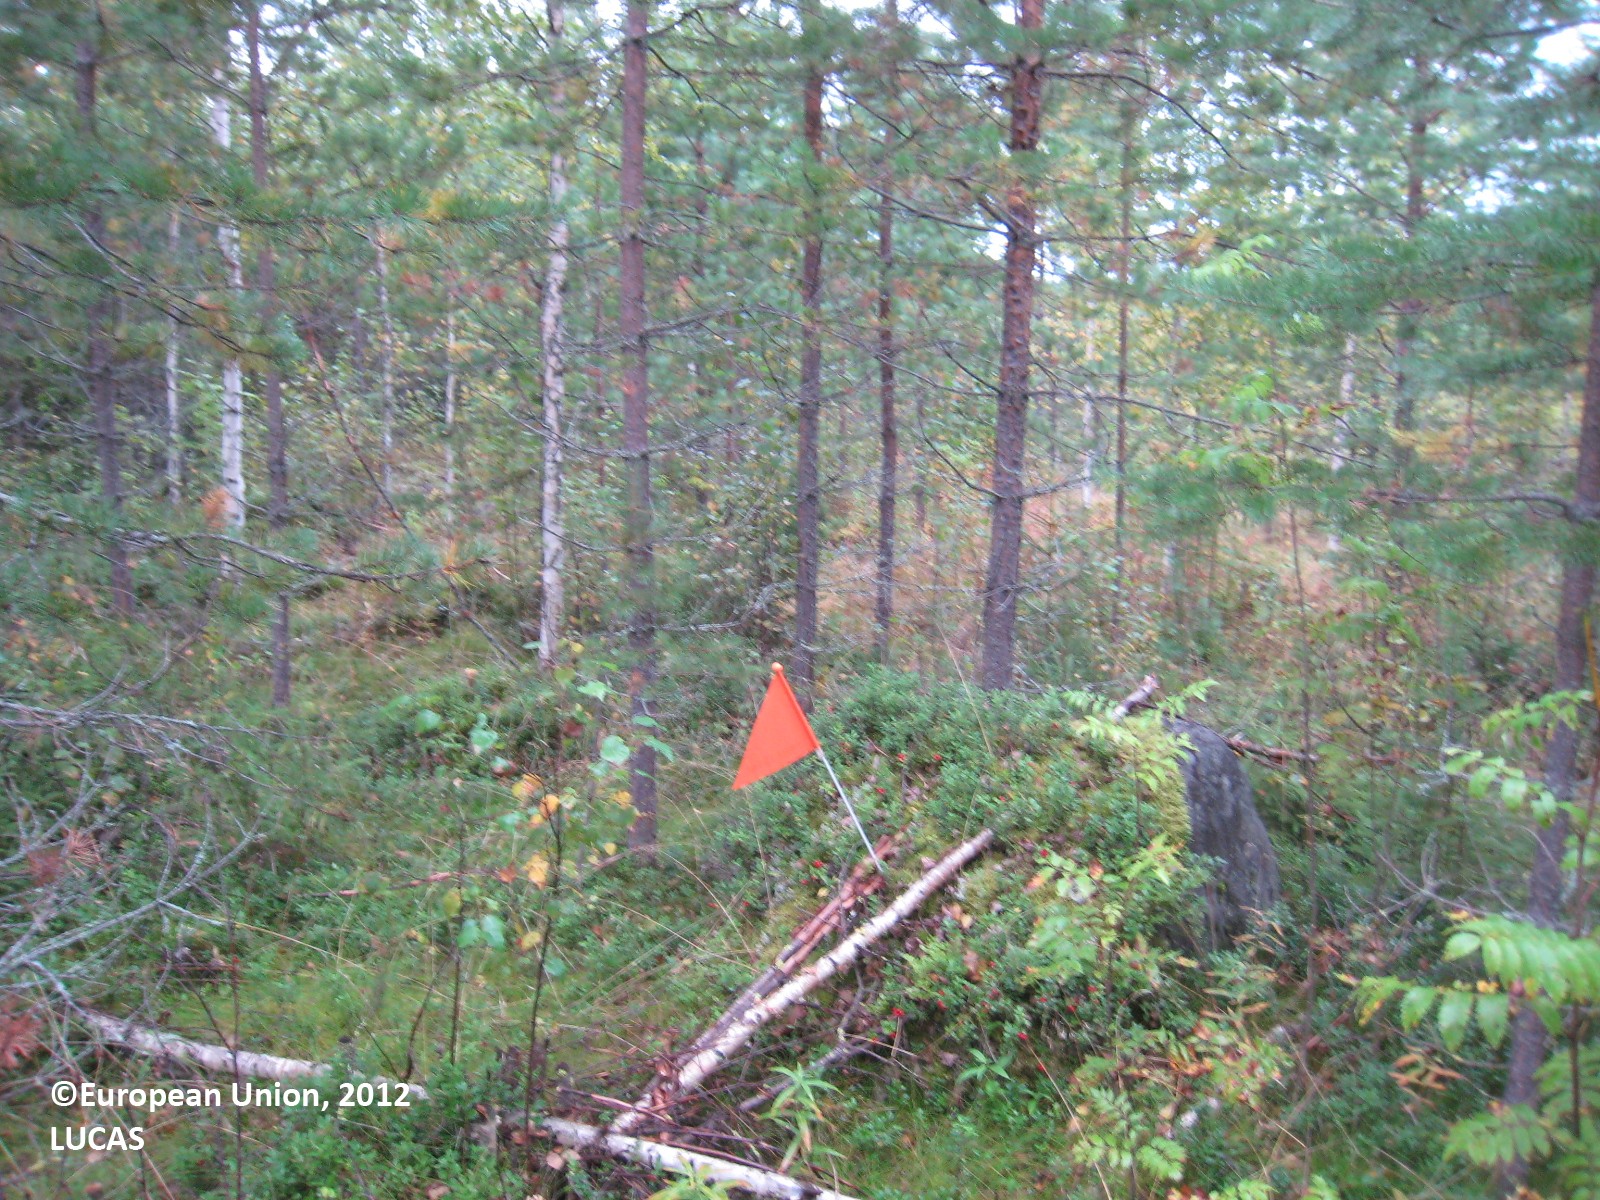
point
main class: Woodland
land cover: Pine dominated mixed woodland
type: boreal forest
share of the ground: > 75 %
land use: Forestry
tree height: > 5 m
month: August
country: FI
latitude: 62.1459
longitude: 27.2182
